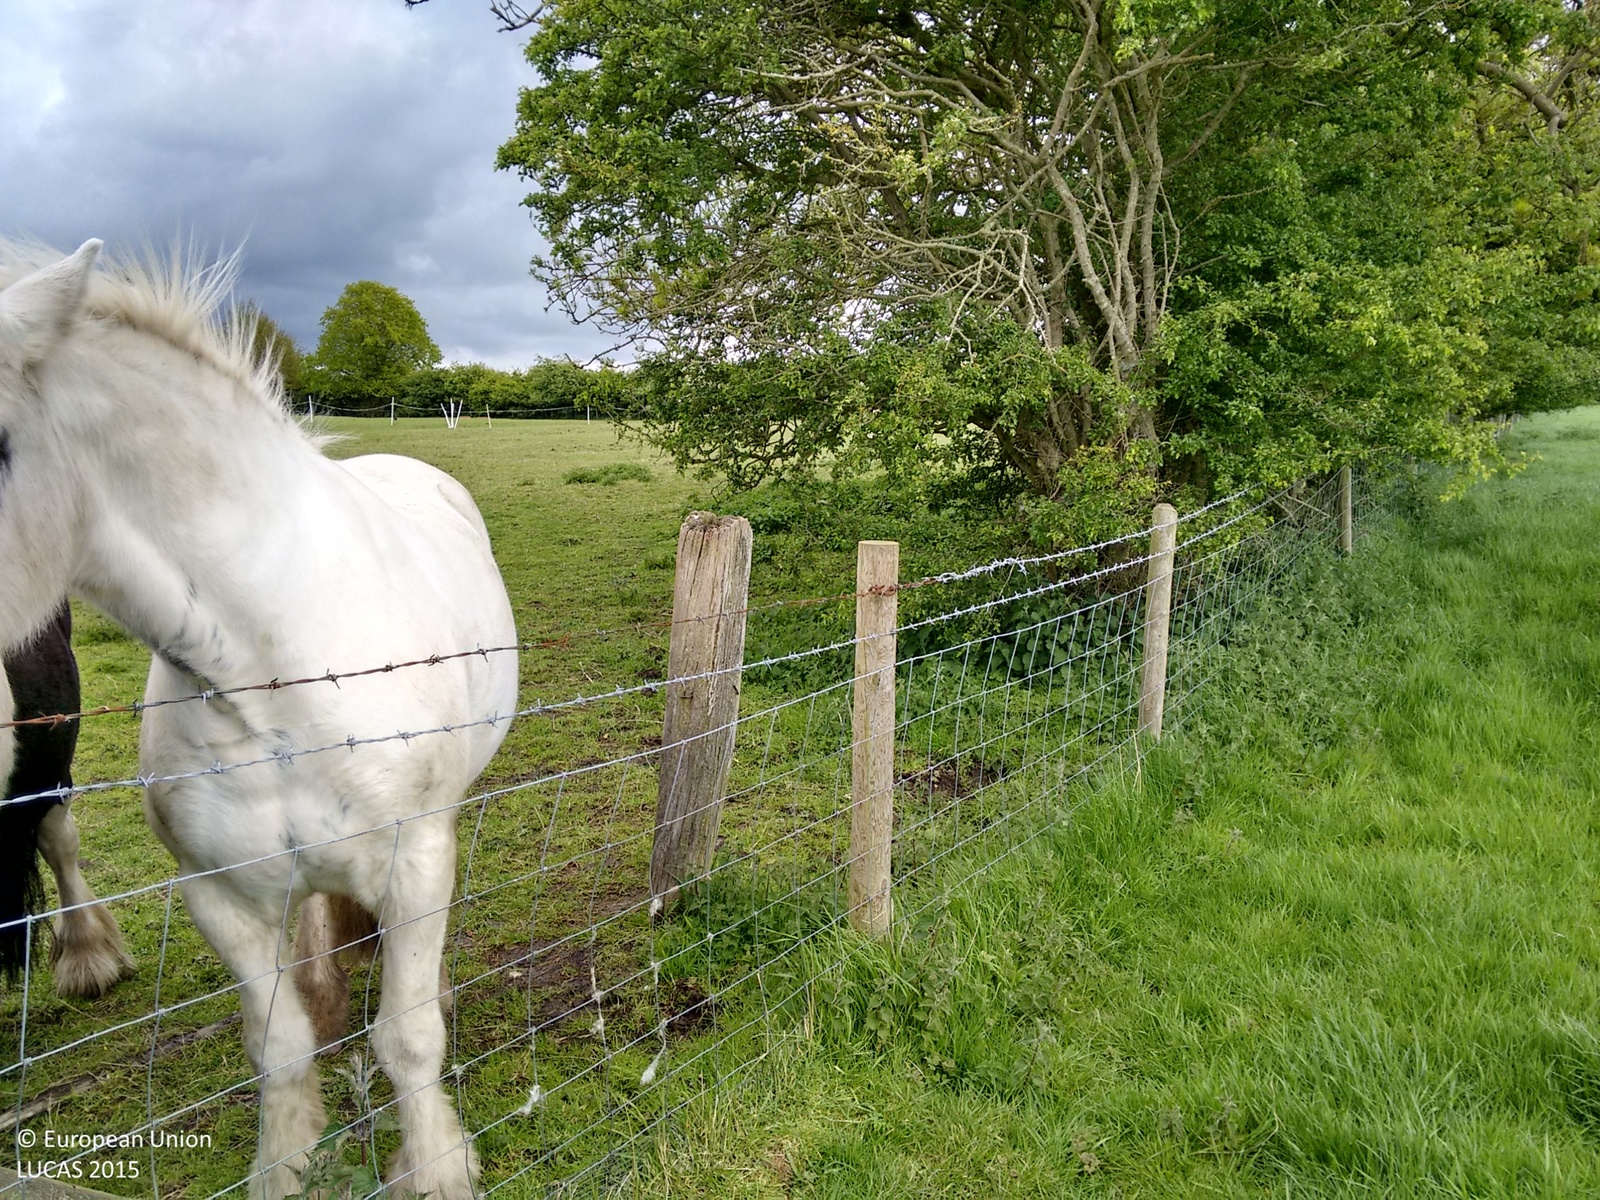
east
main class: Grassland
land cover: Grassland without tree/shrub cover
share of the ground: > 75 %
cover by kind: herbaceous plants 100 %
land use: Agriculture (excluding fallow land and kitchen gardens)
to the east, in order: Grassland without tree/shrub cover; Fences; Managed hedges; Grass margins; Other bare soil; Grass margins; Managed hedges; Grassland without tree/shrub cover; Managed hedges; Grass margins; Arable land (only in case pi)
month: May
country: GB
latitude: 53.3657
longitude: -0.2384
